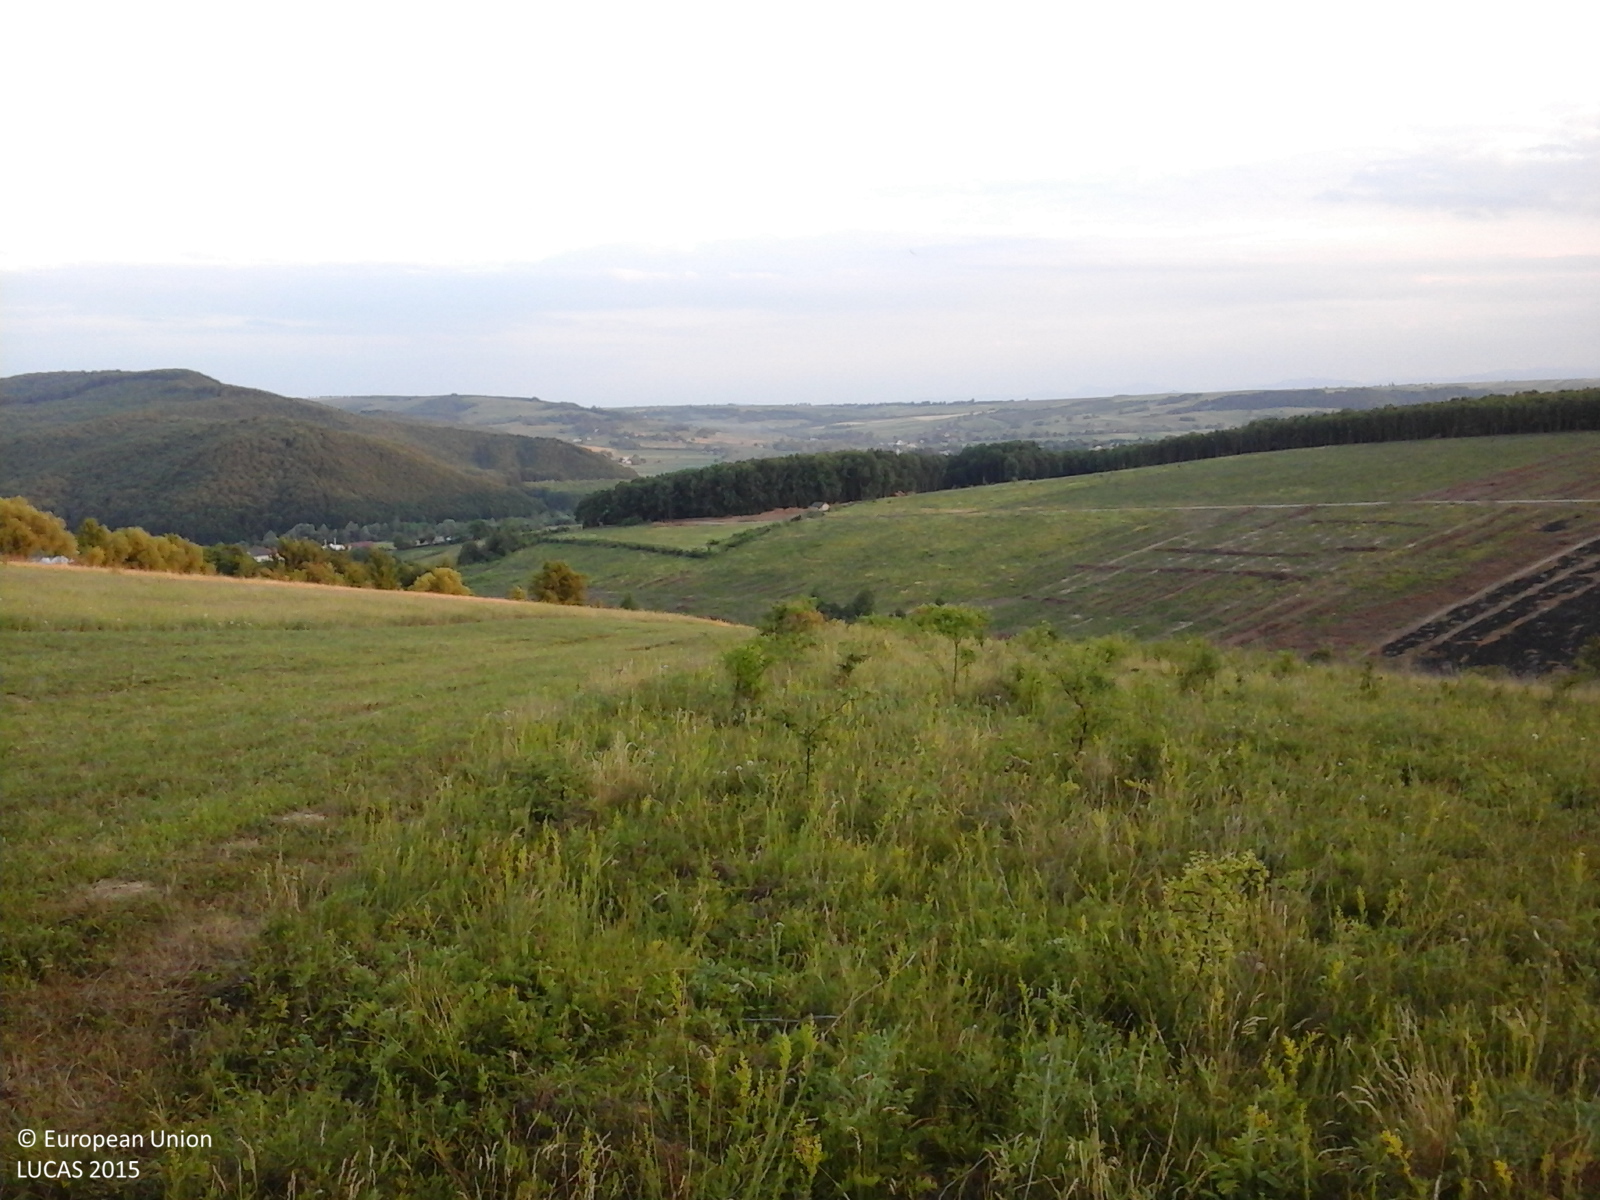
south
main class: Grassland
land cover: Grassland with sparse tree/shrub cover
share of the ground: > 75 %
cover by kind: herbaceous plants 90 %, broadleaved forest trees 5 %, shrubs 5 %
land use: Agriculture (excluding fallow land and kitchen gardens)
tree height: < 5 m
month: June
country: RO
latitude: 47.4297
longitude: 26.4877
